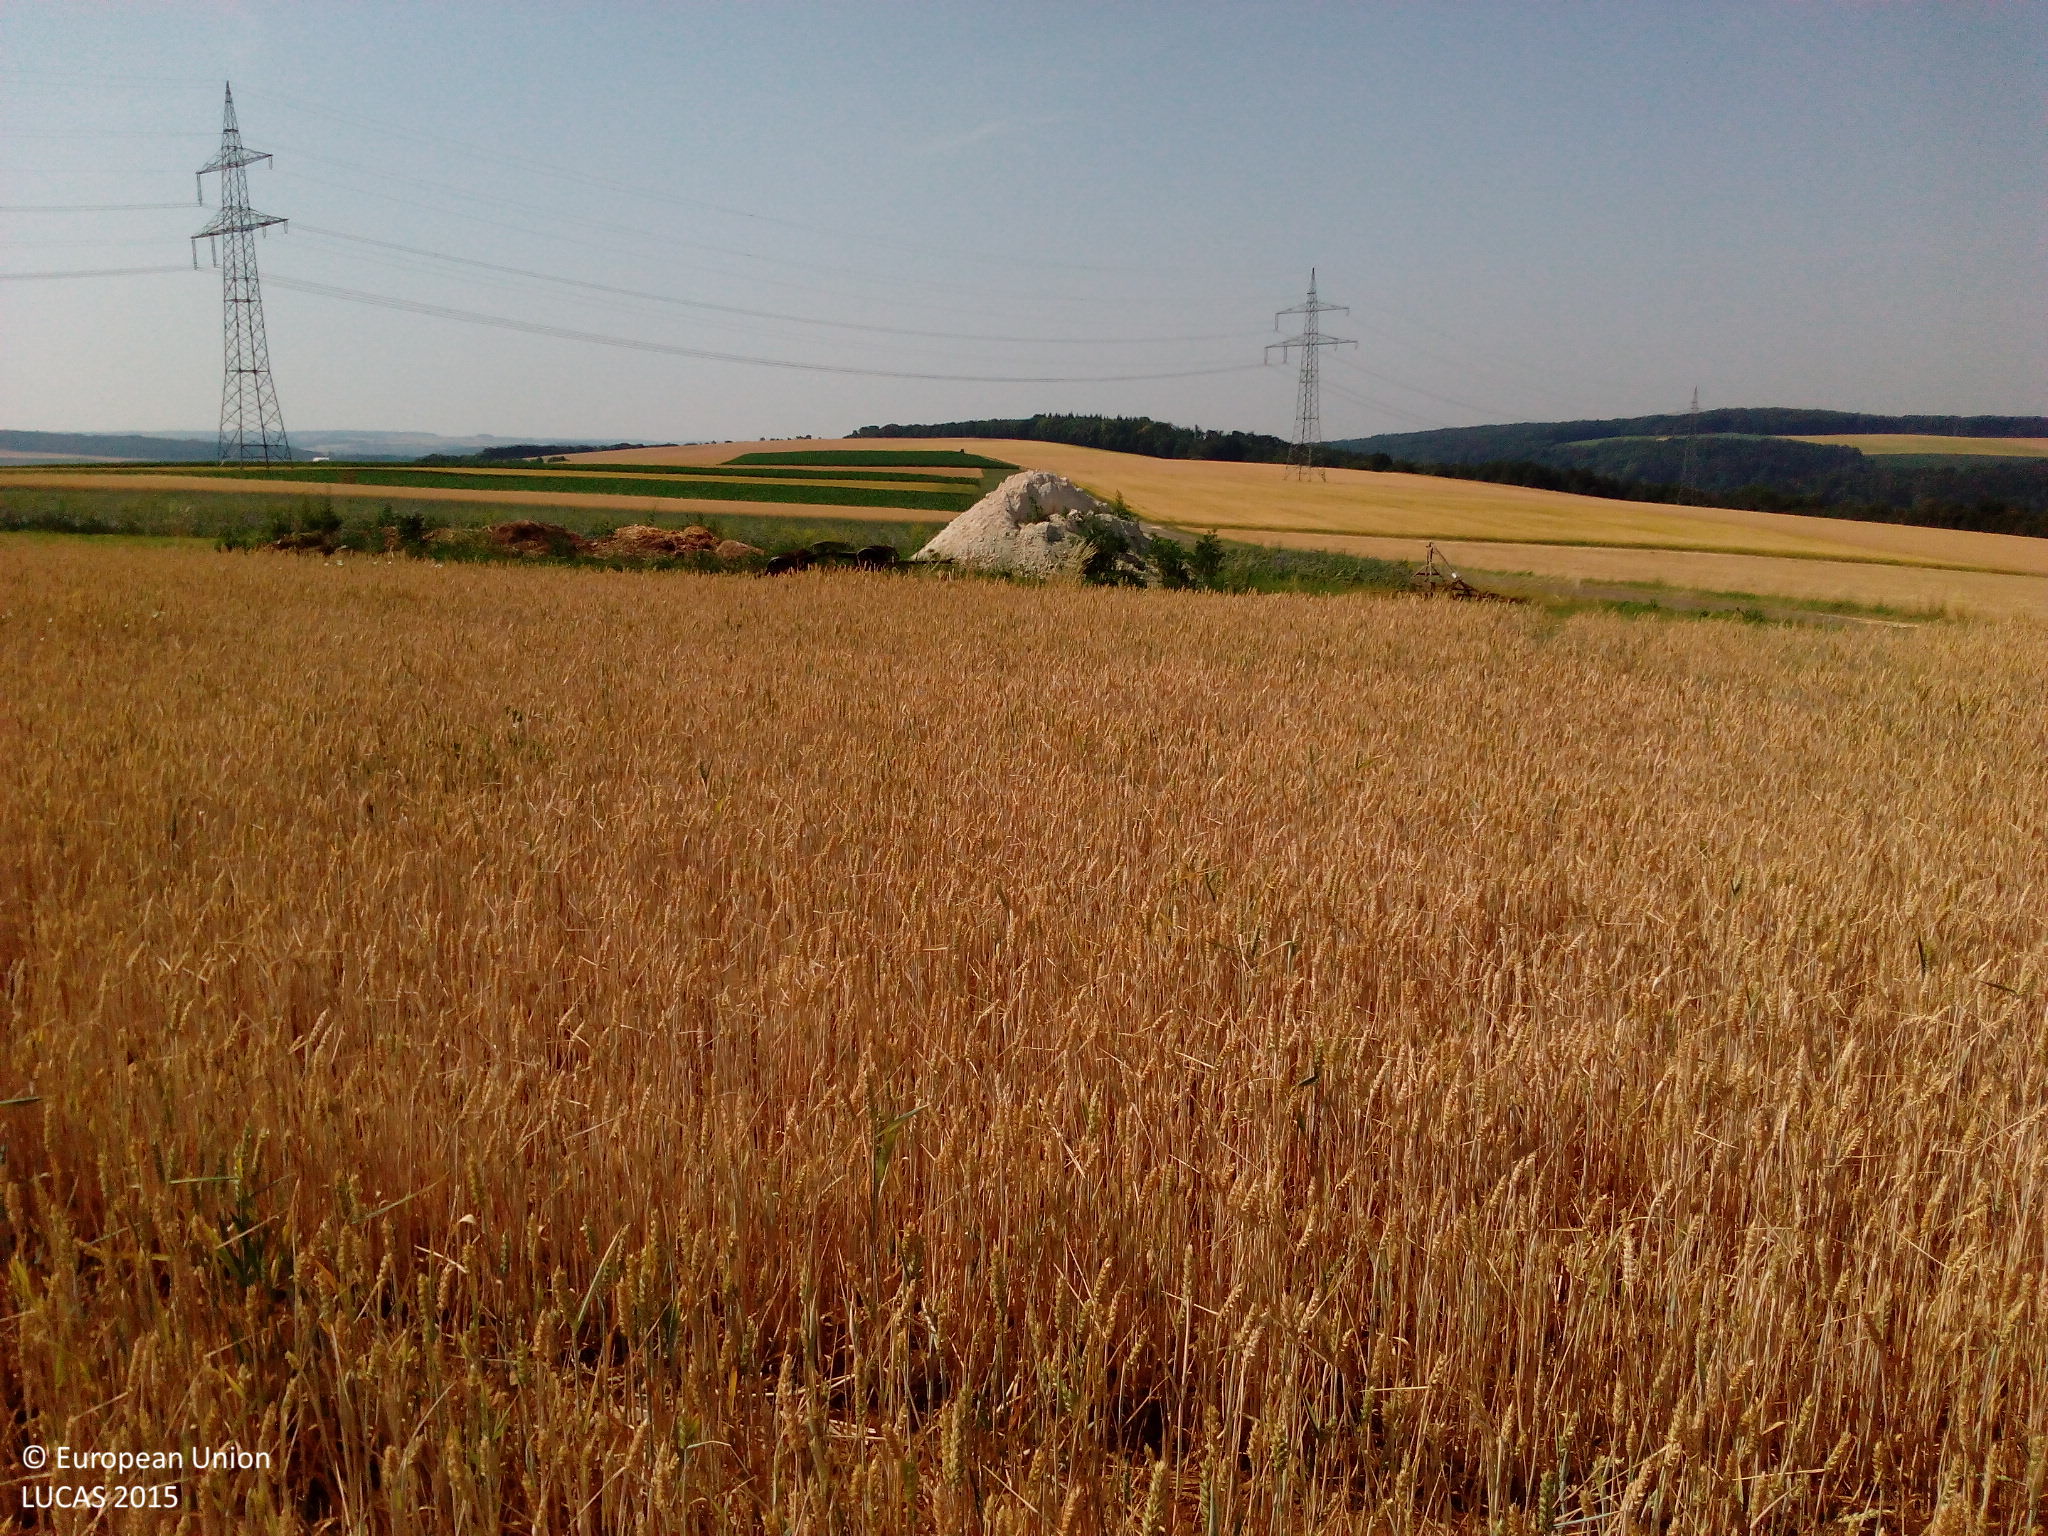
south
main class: Cropland
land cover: Common wheat
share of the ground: > 75 %
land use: Agriculture (excluding fallow land and kitchen gardens)
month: July
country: DE
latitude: 49.5188
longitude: 9.9033
